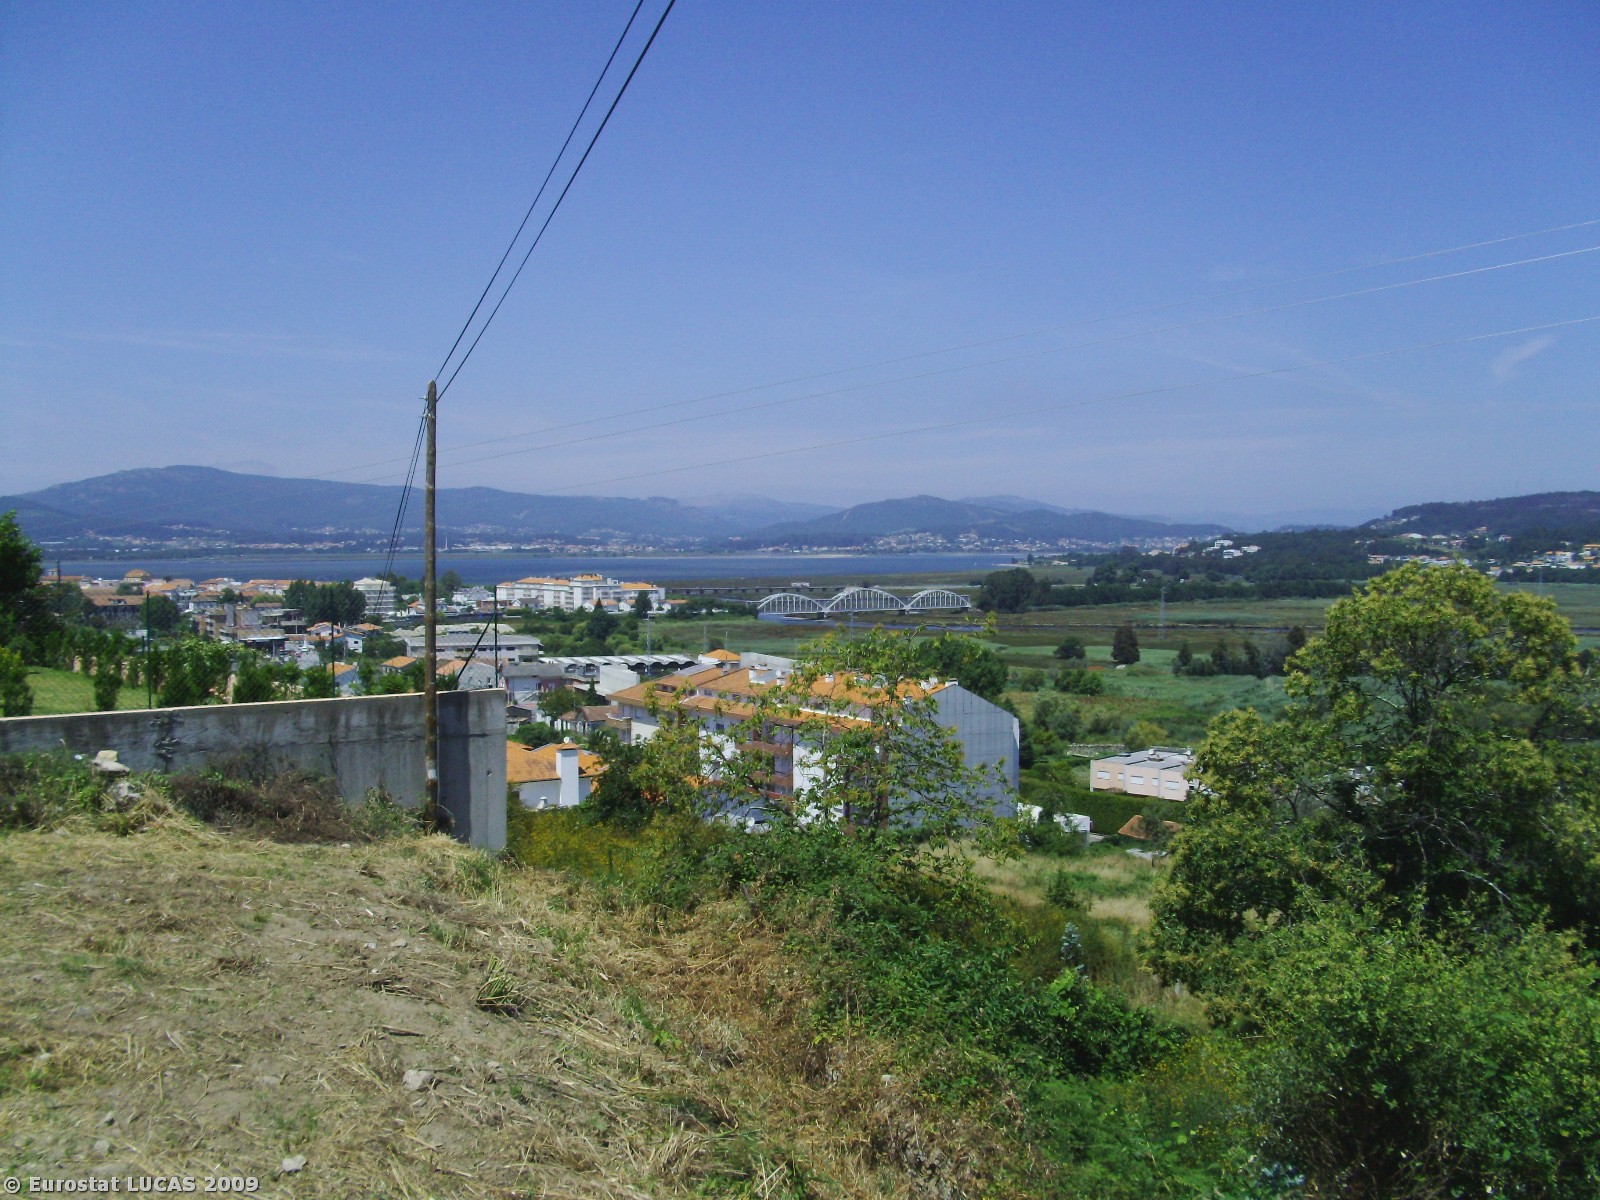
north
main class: Grassland
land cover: Spontaneously vegetated surfaces
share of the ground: > 75 %
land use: Fallow land
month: July
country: PT
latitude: 41.8670
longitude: -8.8335
